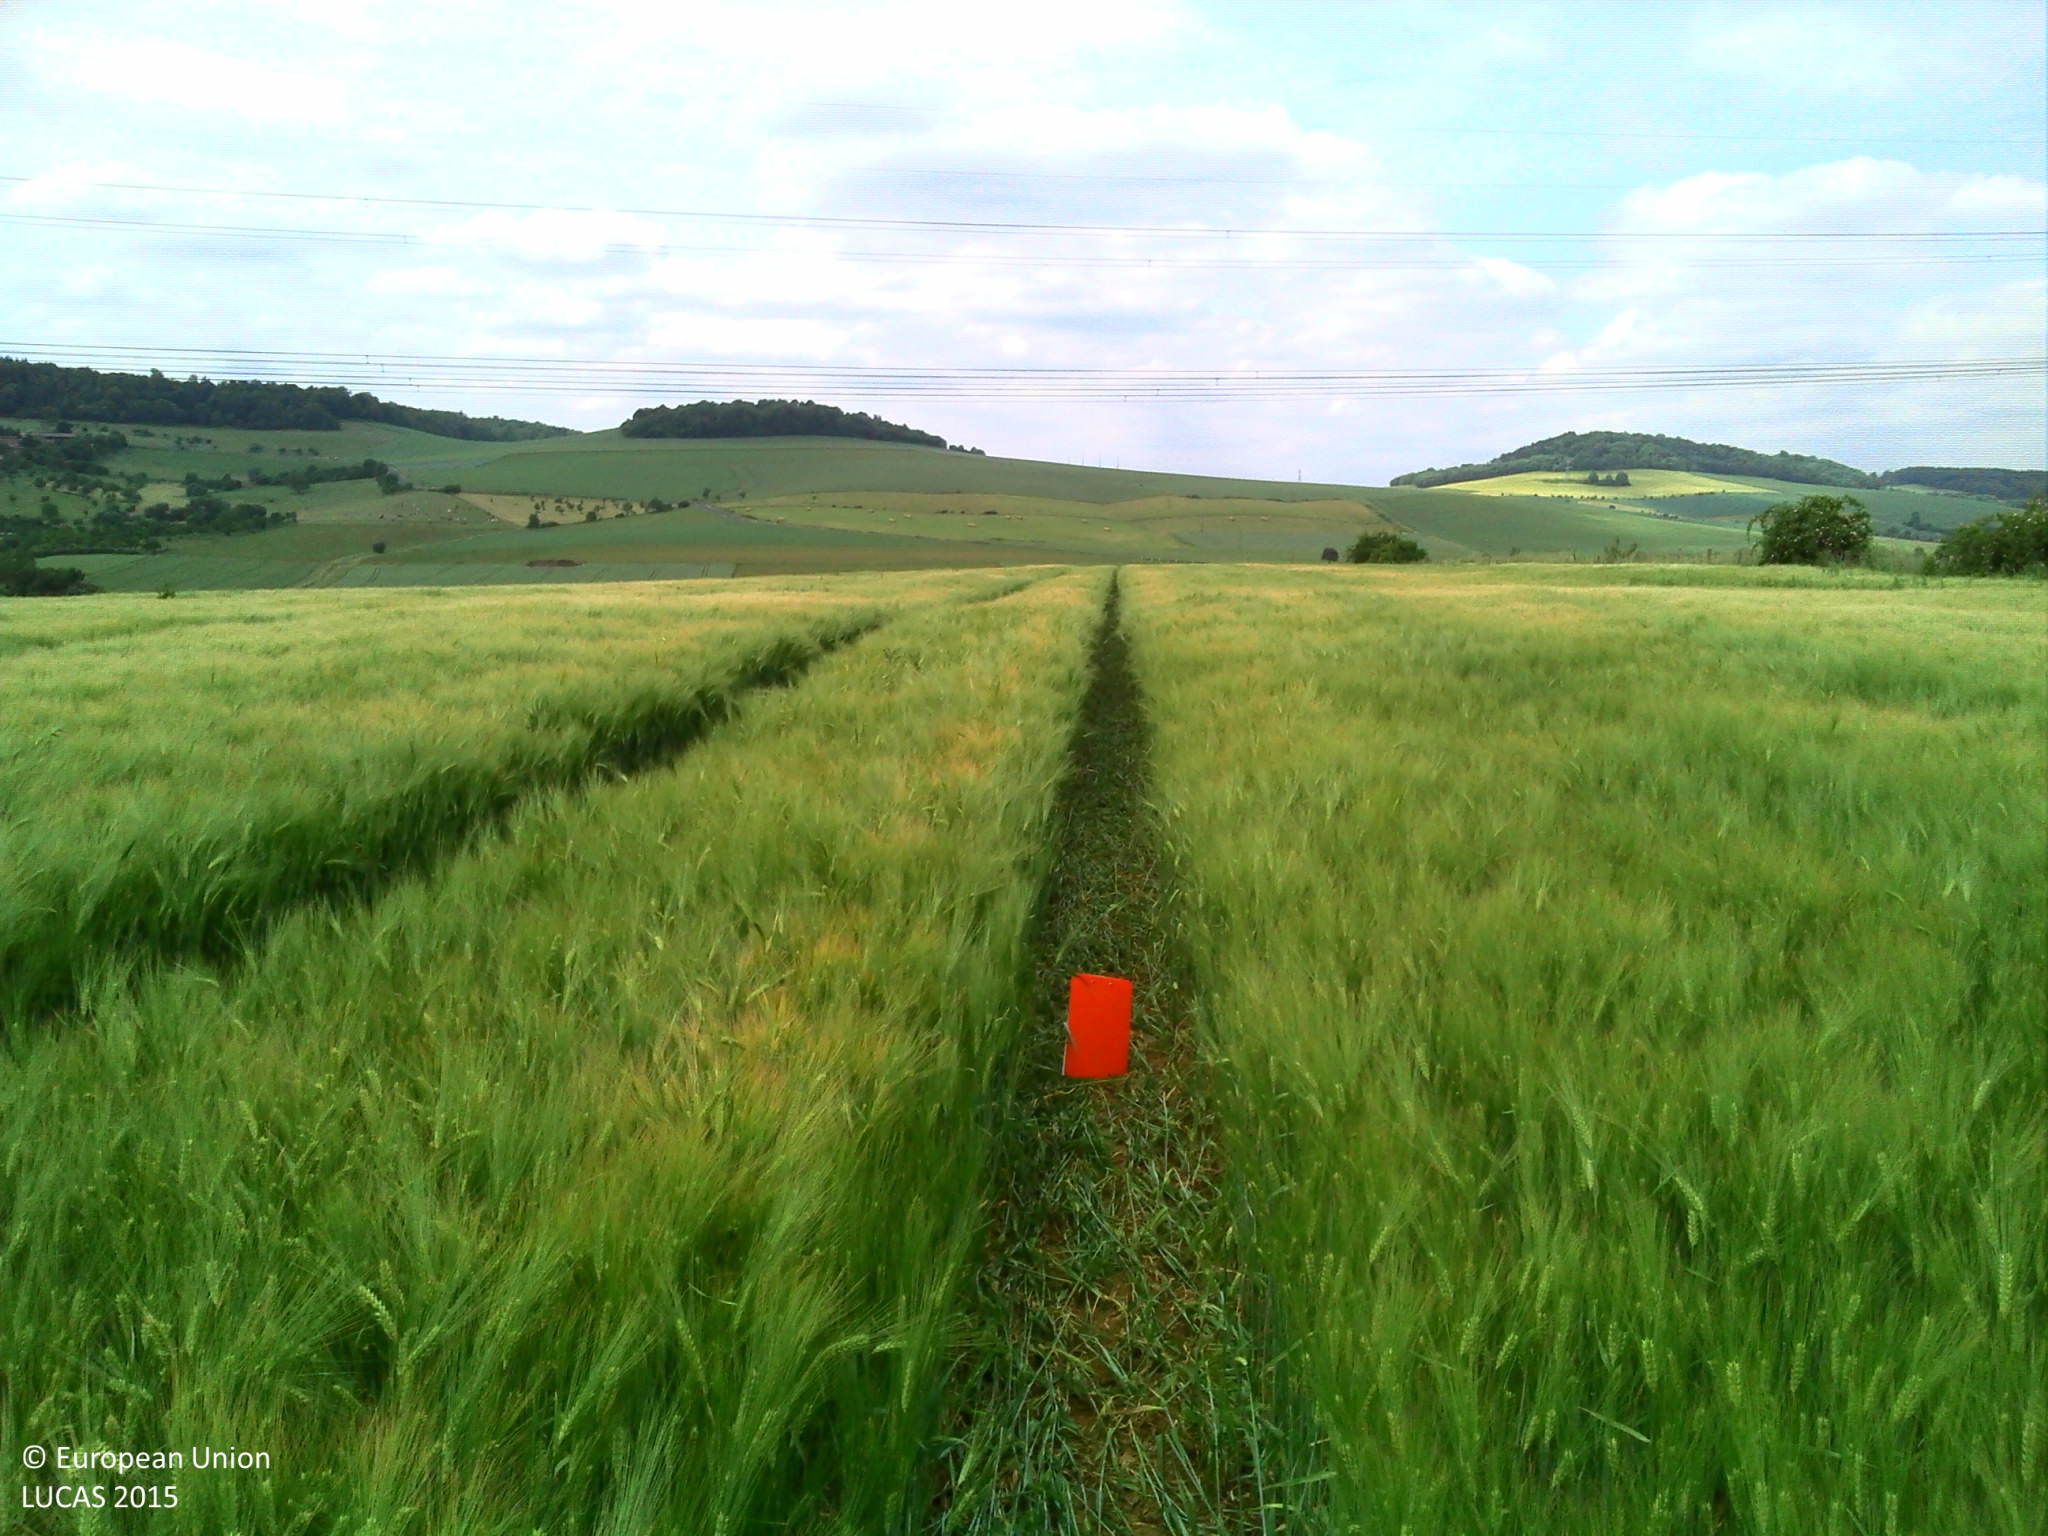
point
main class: Cropland
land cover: Barley
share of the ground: > 75 %
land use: Agriculture (excluding fallow land and kitchen gardens)
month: June
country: FR
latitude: 48.8415
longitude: 6.1711
